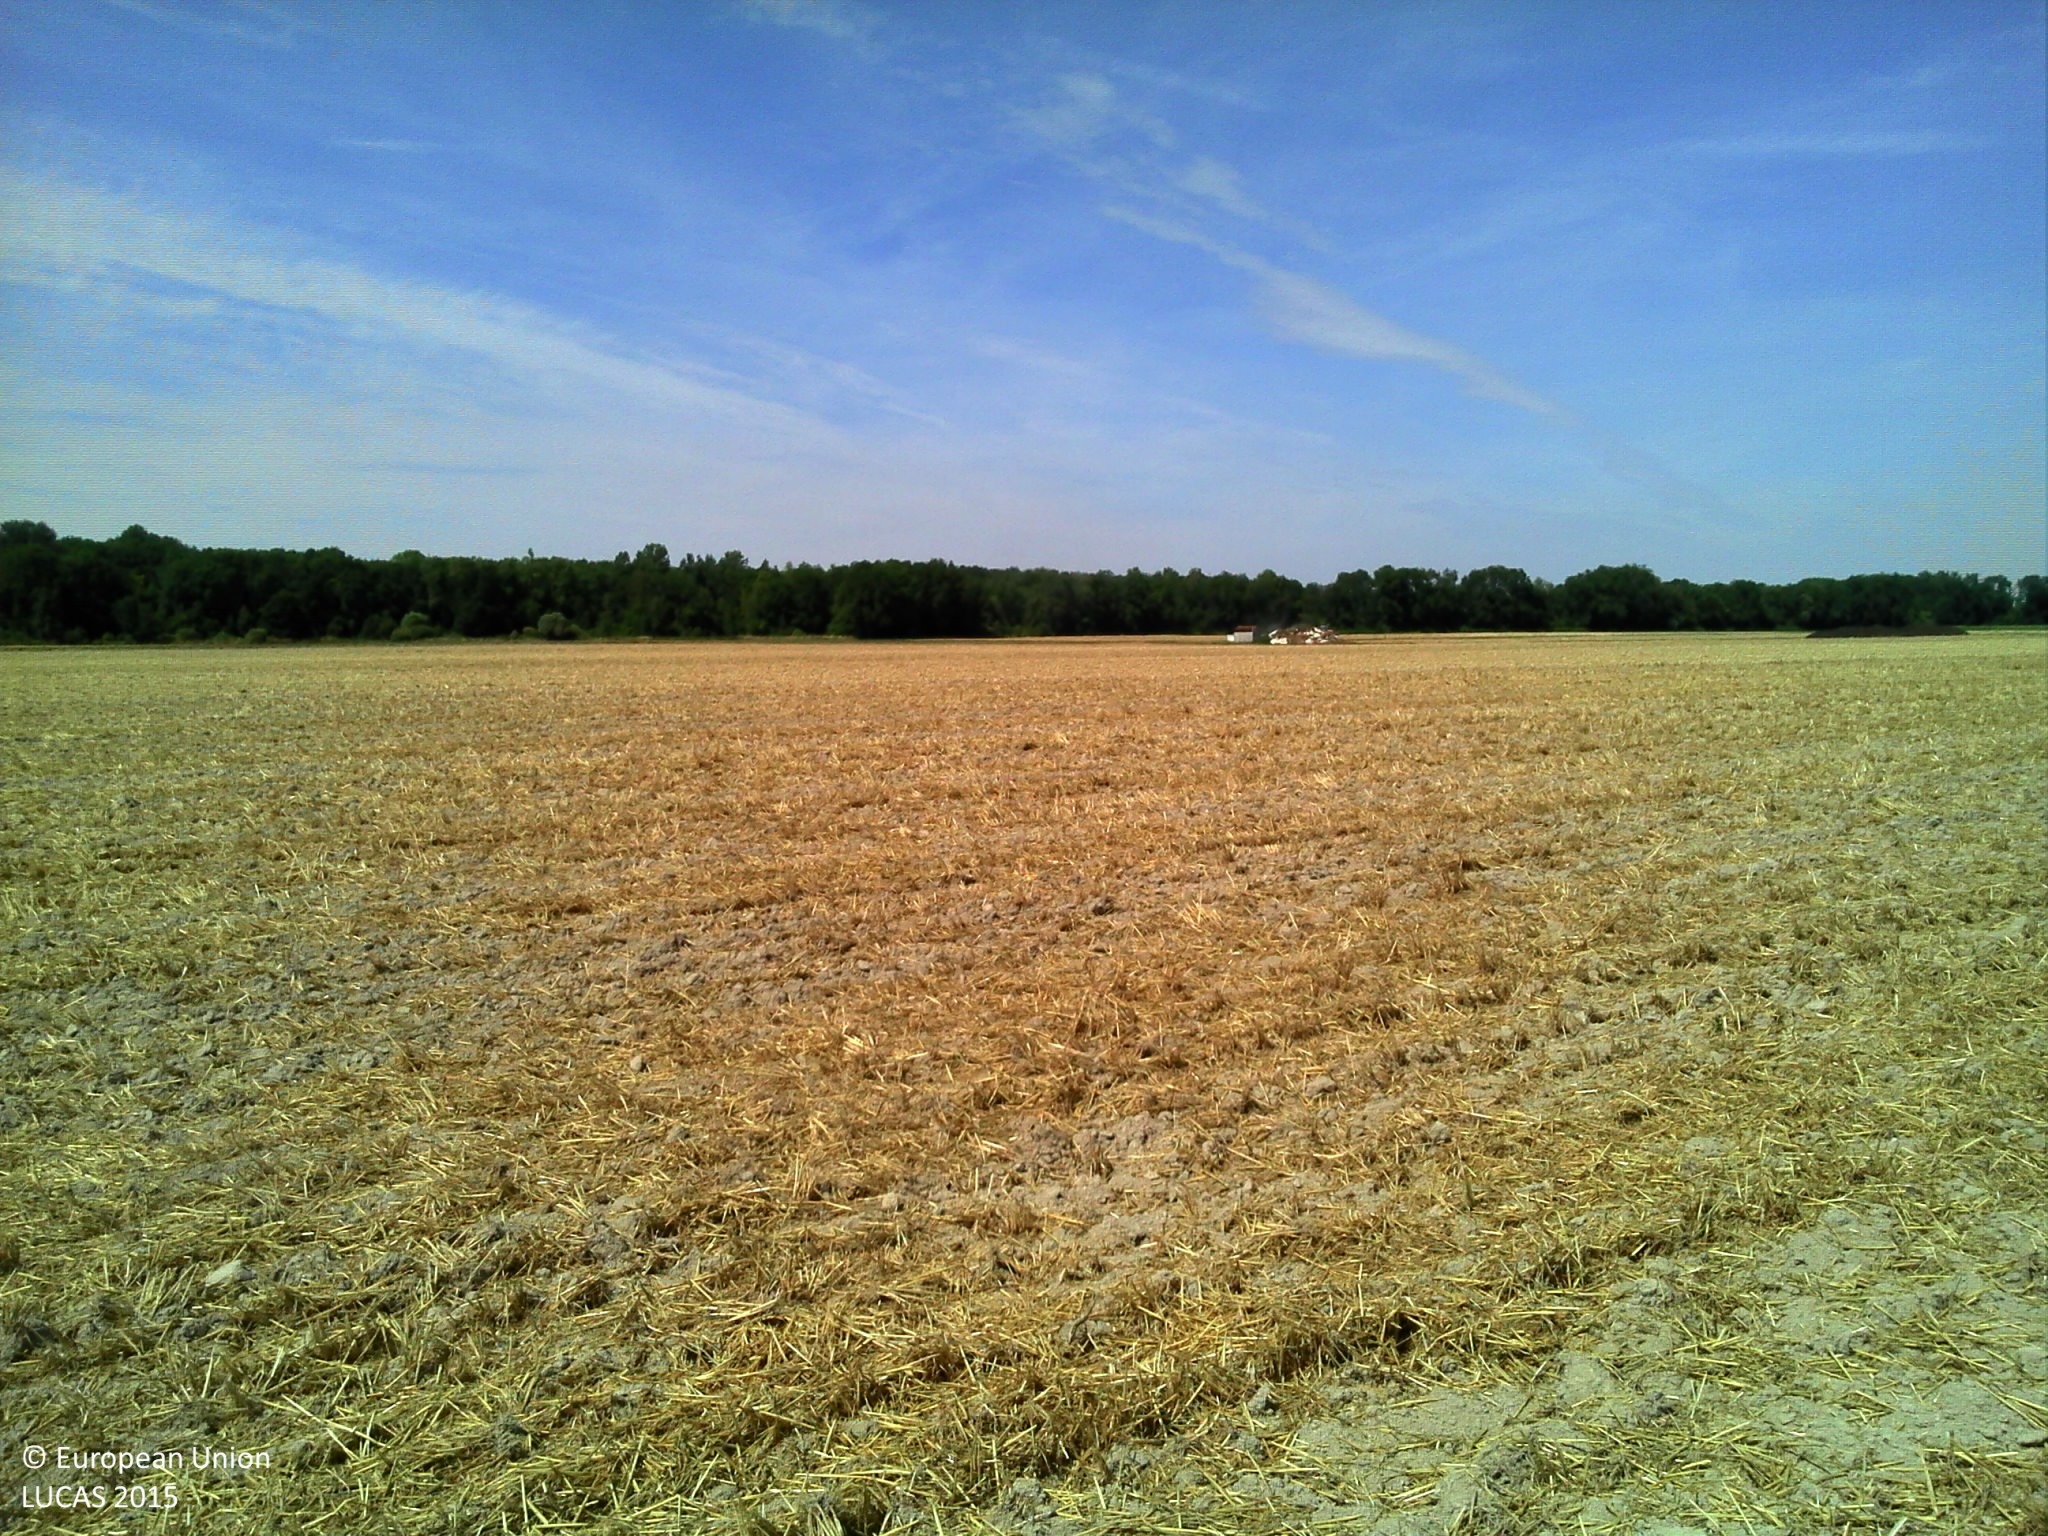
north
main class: Cropland
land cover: Common wheat
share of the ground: > 75 %
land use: Agriculture (excluding fallow land and kitchen gardens)
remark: Harvested field
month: August
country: FR
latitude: 48.9529
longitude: 4.1646
